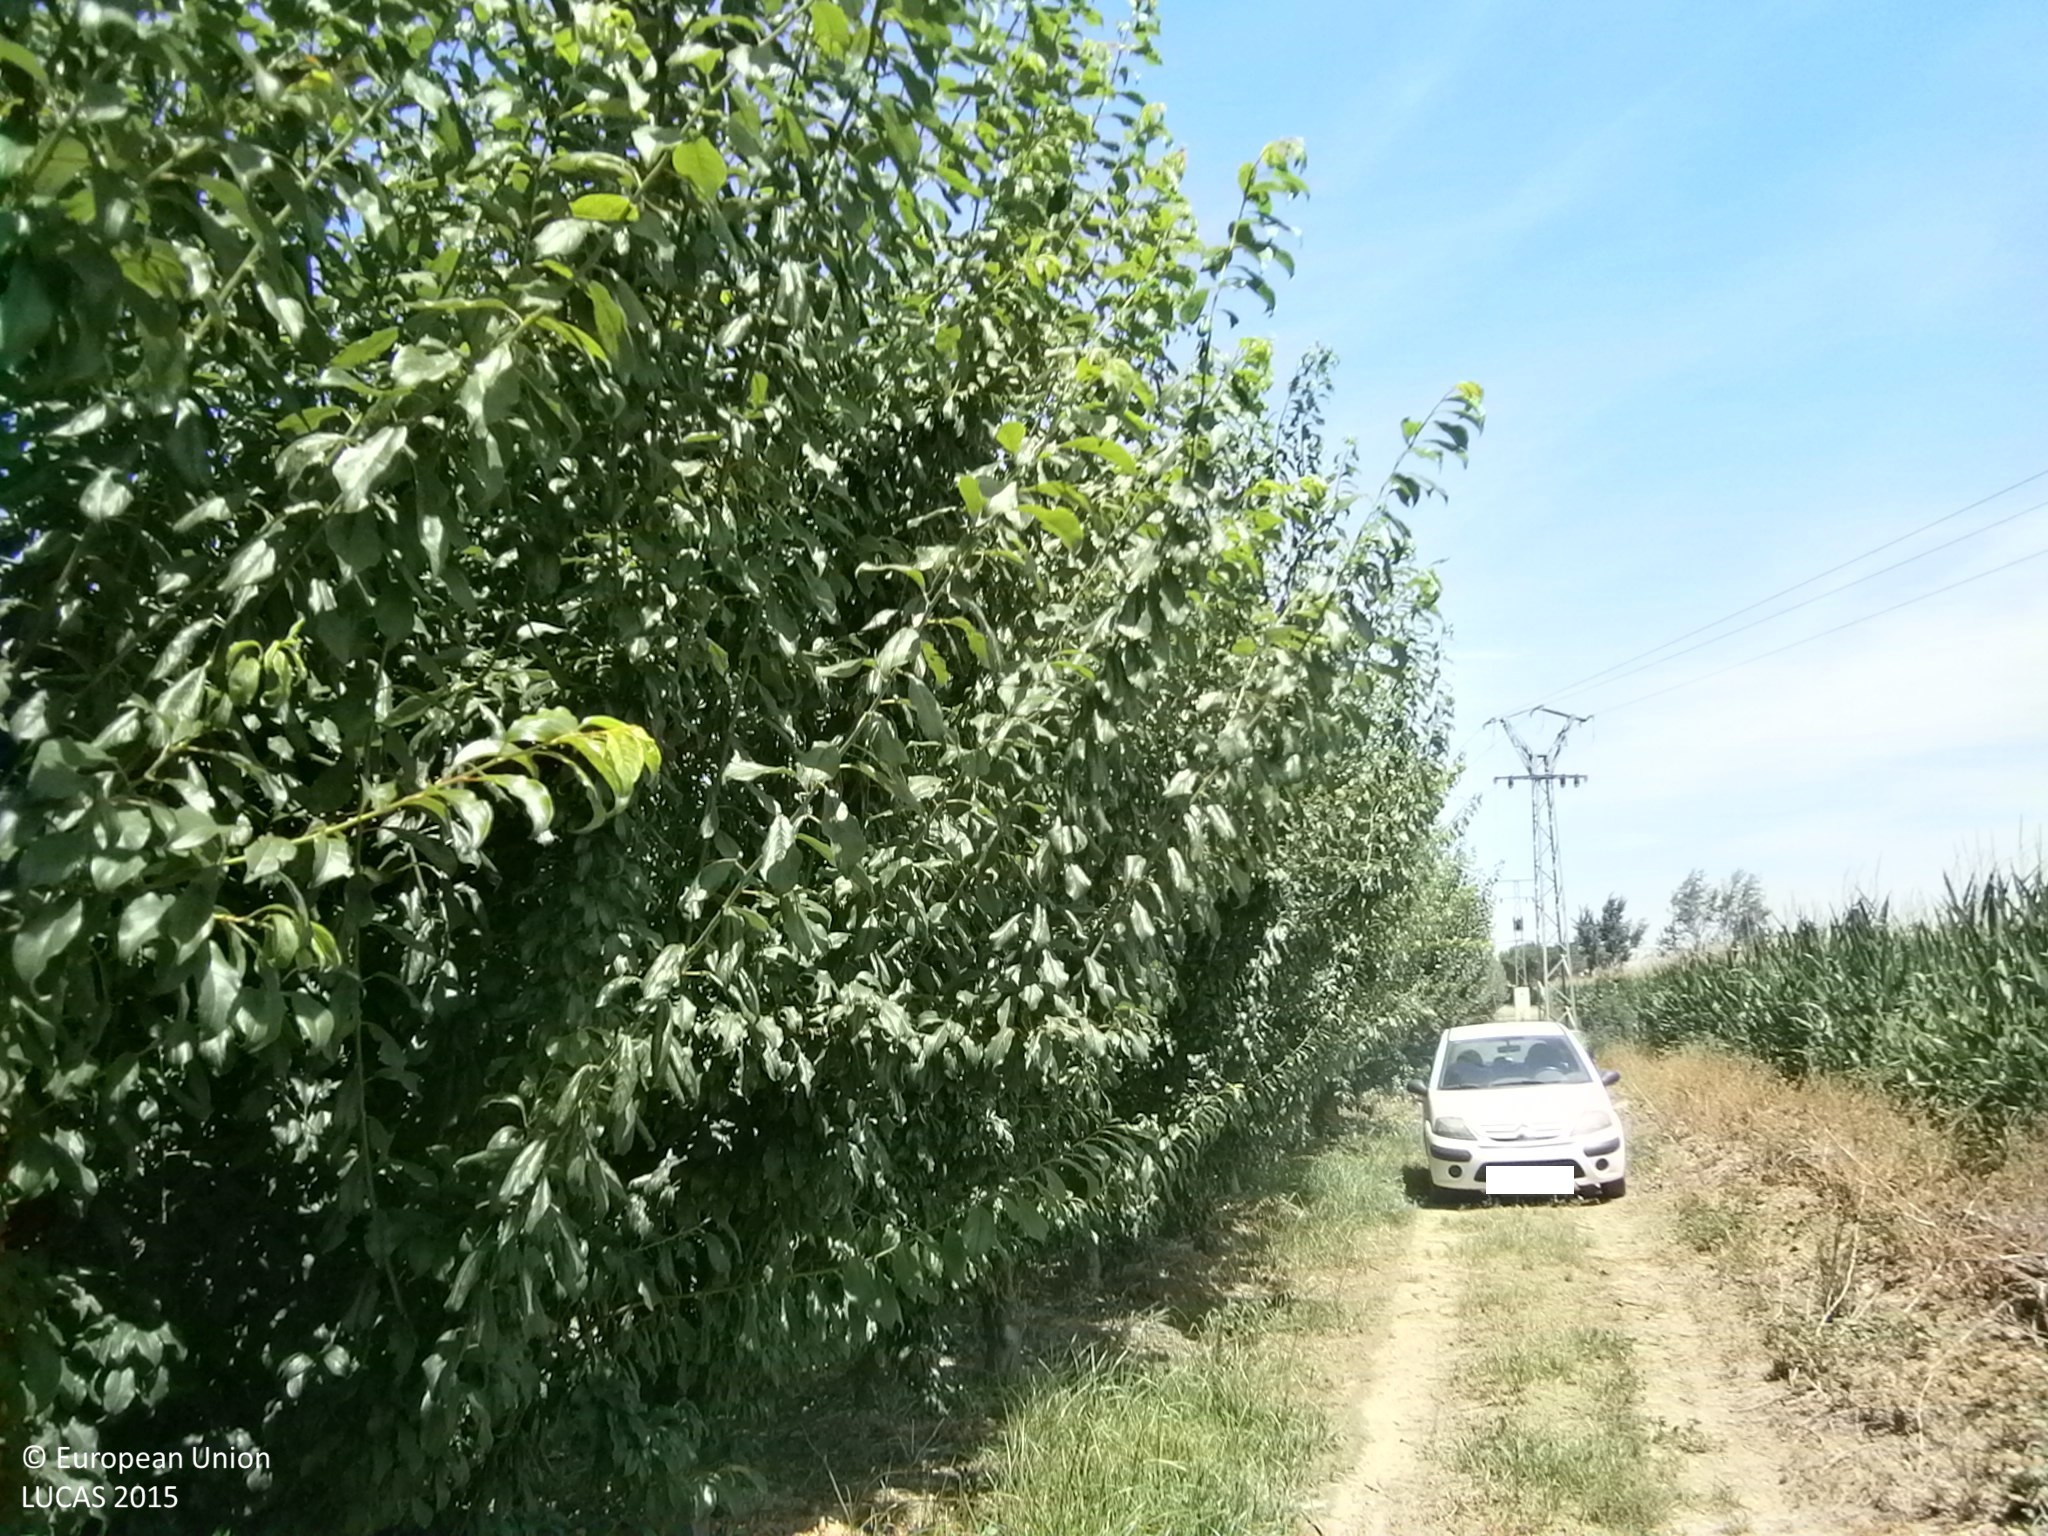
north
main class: Cropland
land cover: Other fruit trees and berries
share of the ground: > 75 %
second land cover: Spontaneously vegetated surfaces
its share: 10 - 25 %
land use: Agriculture (excluding fallow land and kitchen gardens)
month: June
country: ES
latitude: 38.9018
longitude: -6.6800
